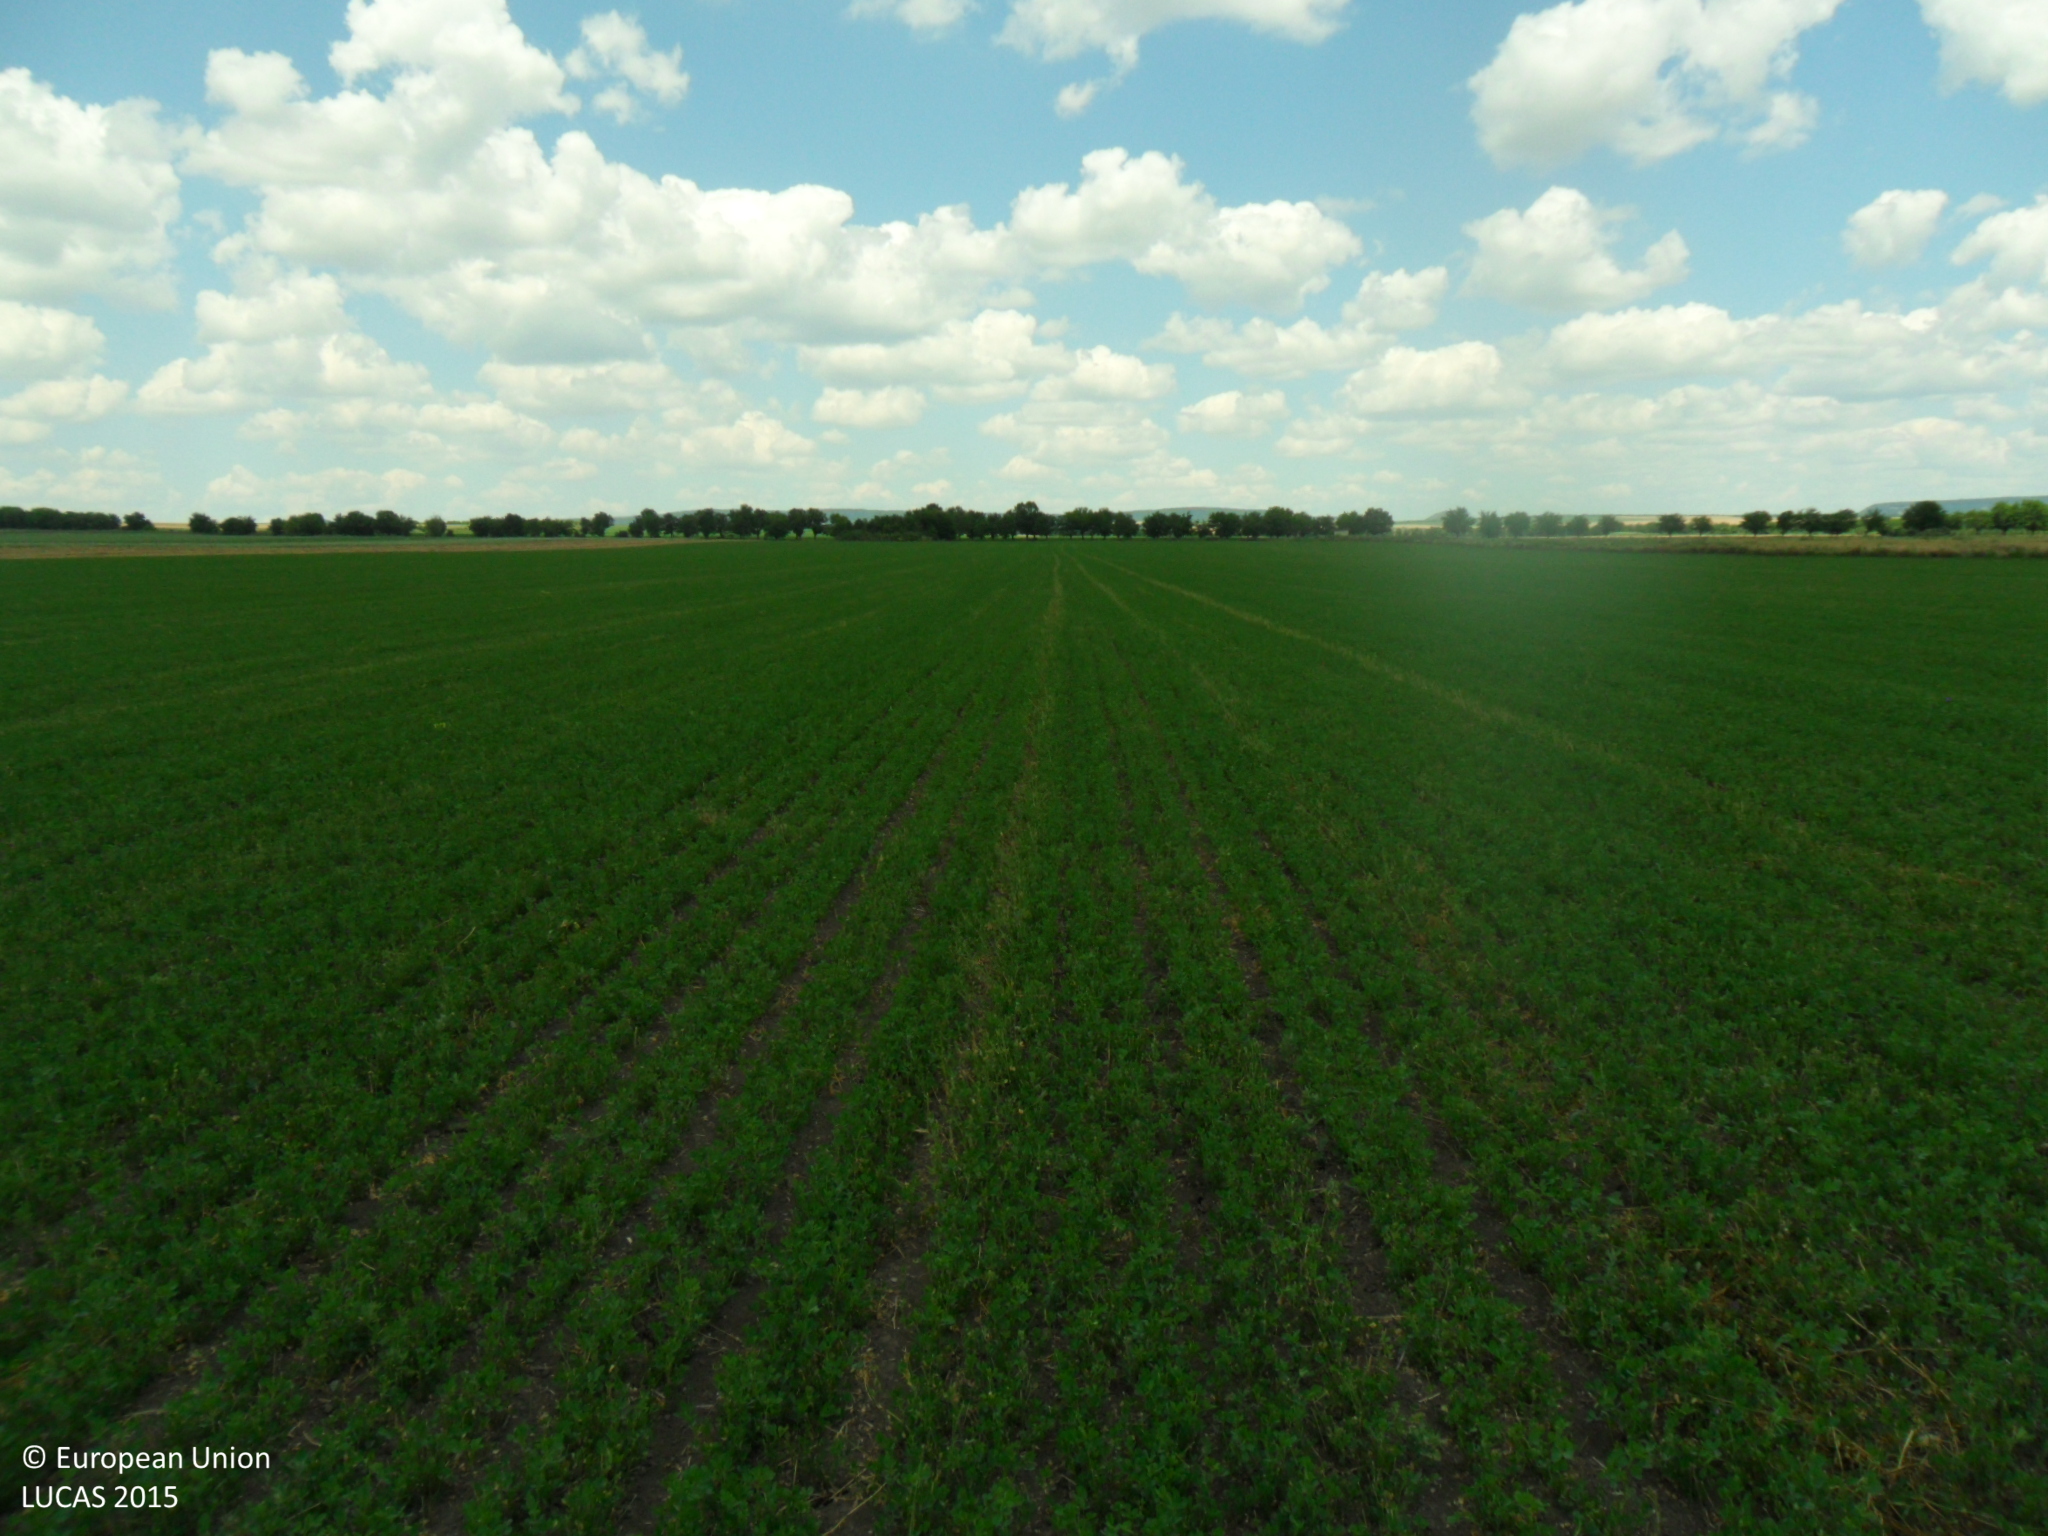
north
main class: Cropland
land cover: Lucerne
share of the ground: > 75 %
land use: Agriculture (excluding fallow land and kitchen gardens)
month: June
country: BG
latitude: 43.3585
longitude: 27.1090
